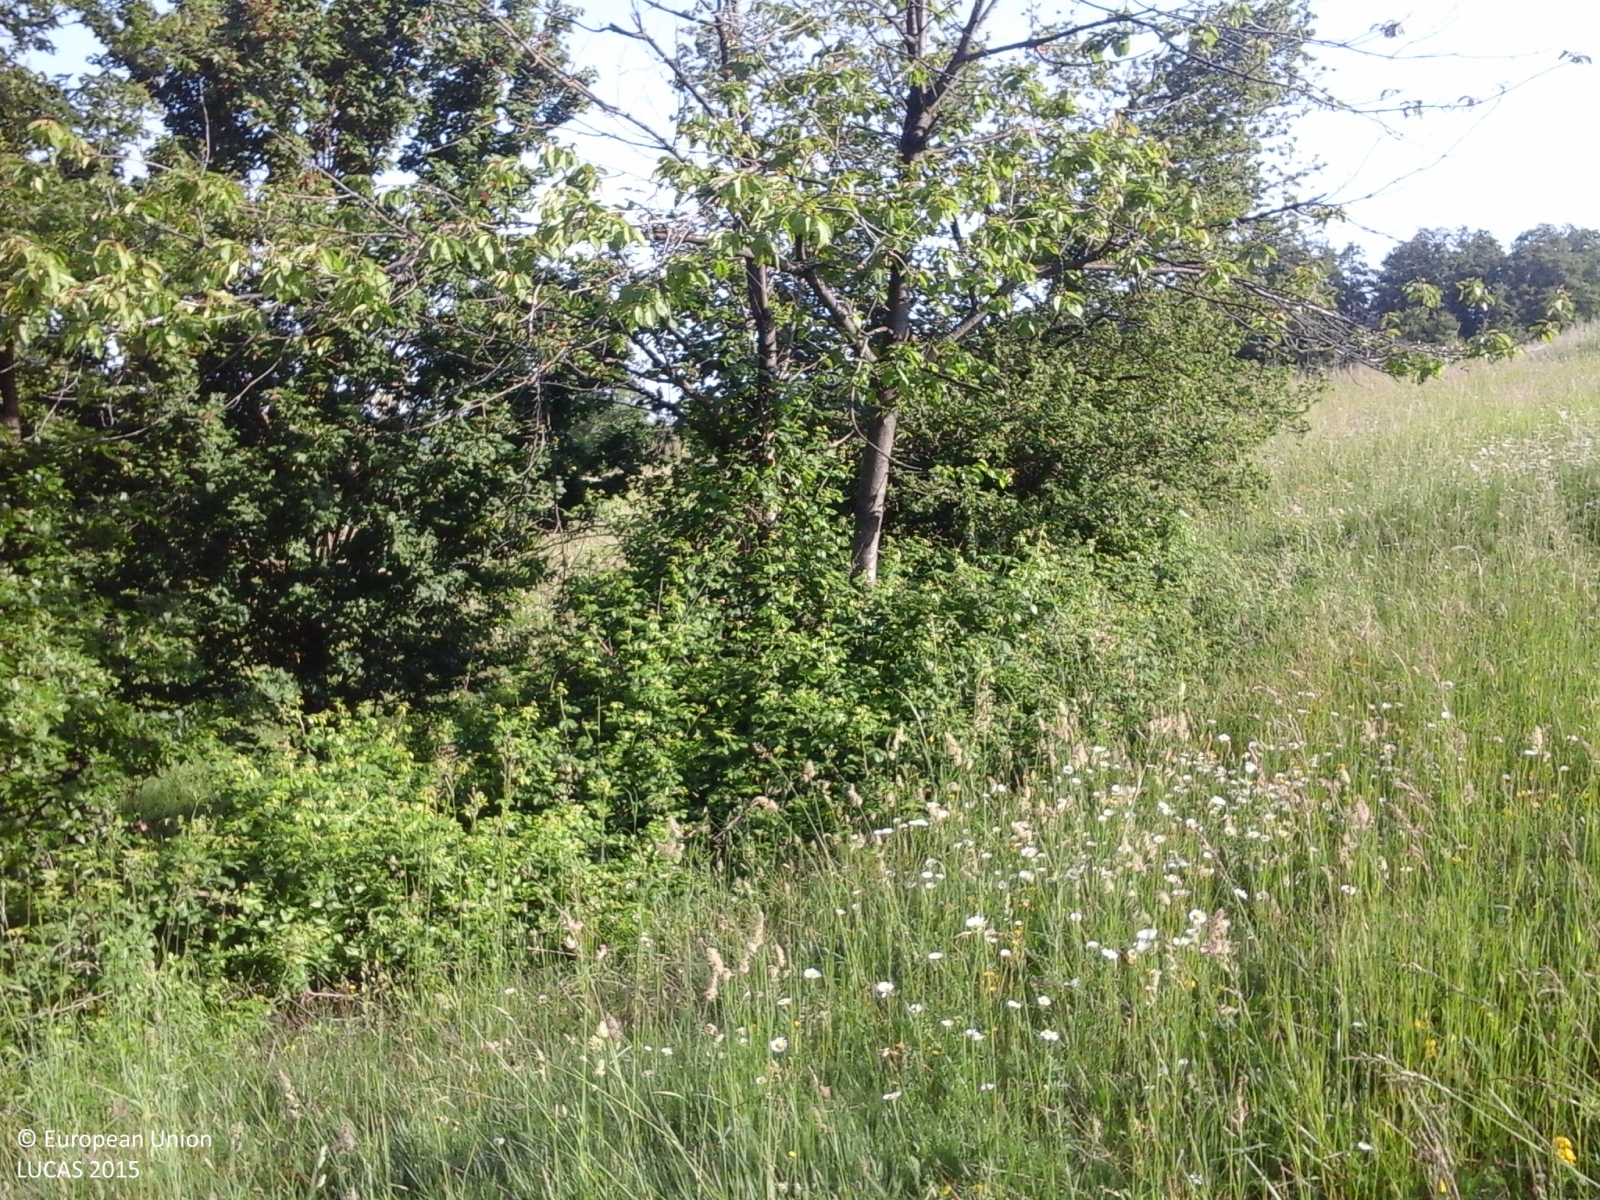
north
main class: Woodland
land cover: Broadleaved woodland
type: mesophytic deciduous forest
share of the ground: > 75 %
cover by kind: broadleaved forest trees 100 %
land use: Forestry
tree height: > 5 m
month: May
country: IT
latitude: 44.4371
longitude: 10.8649
